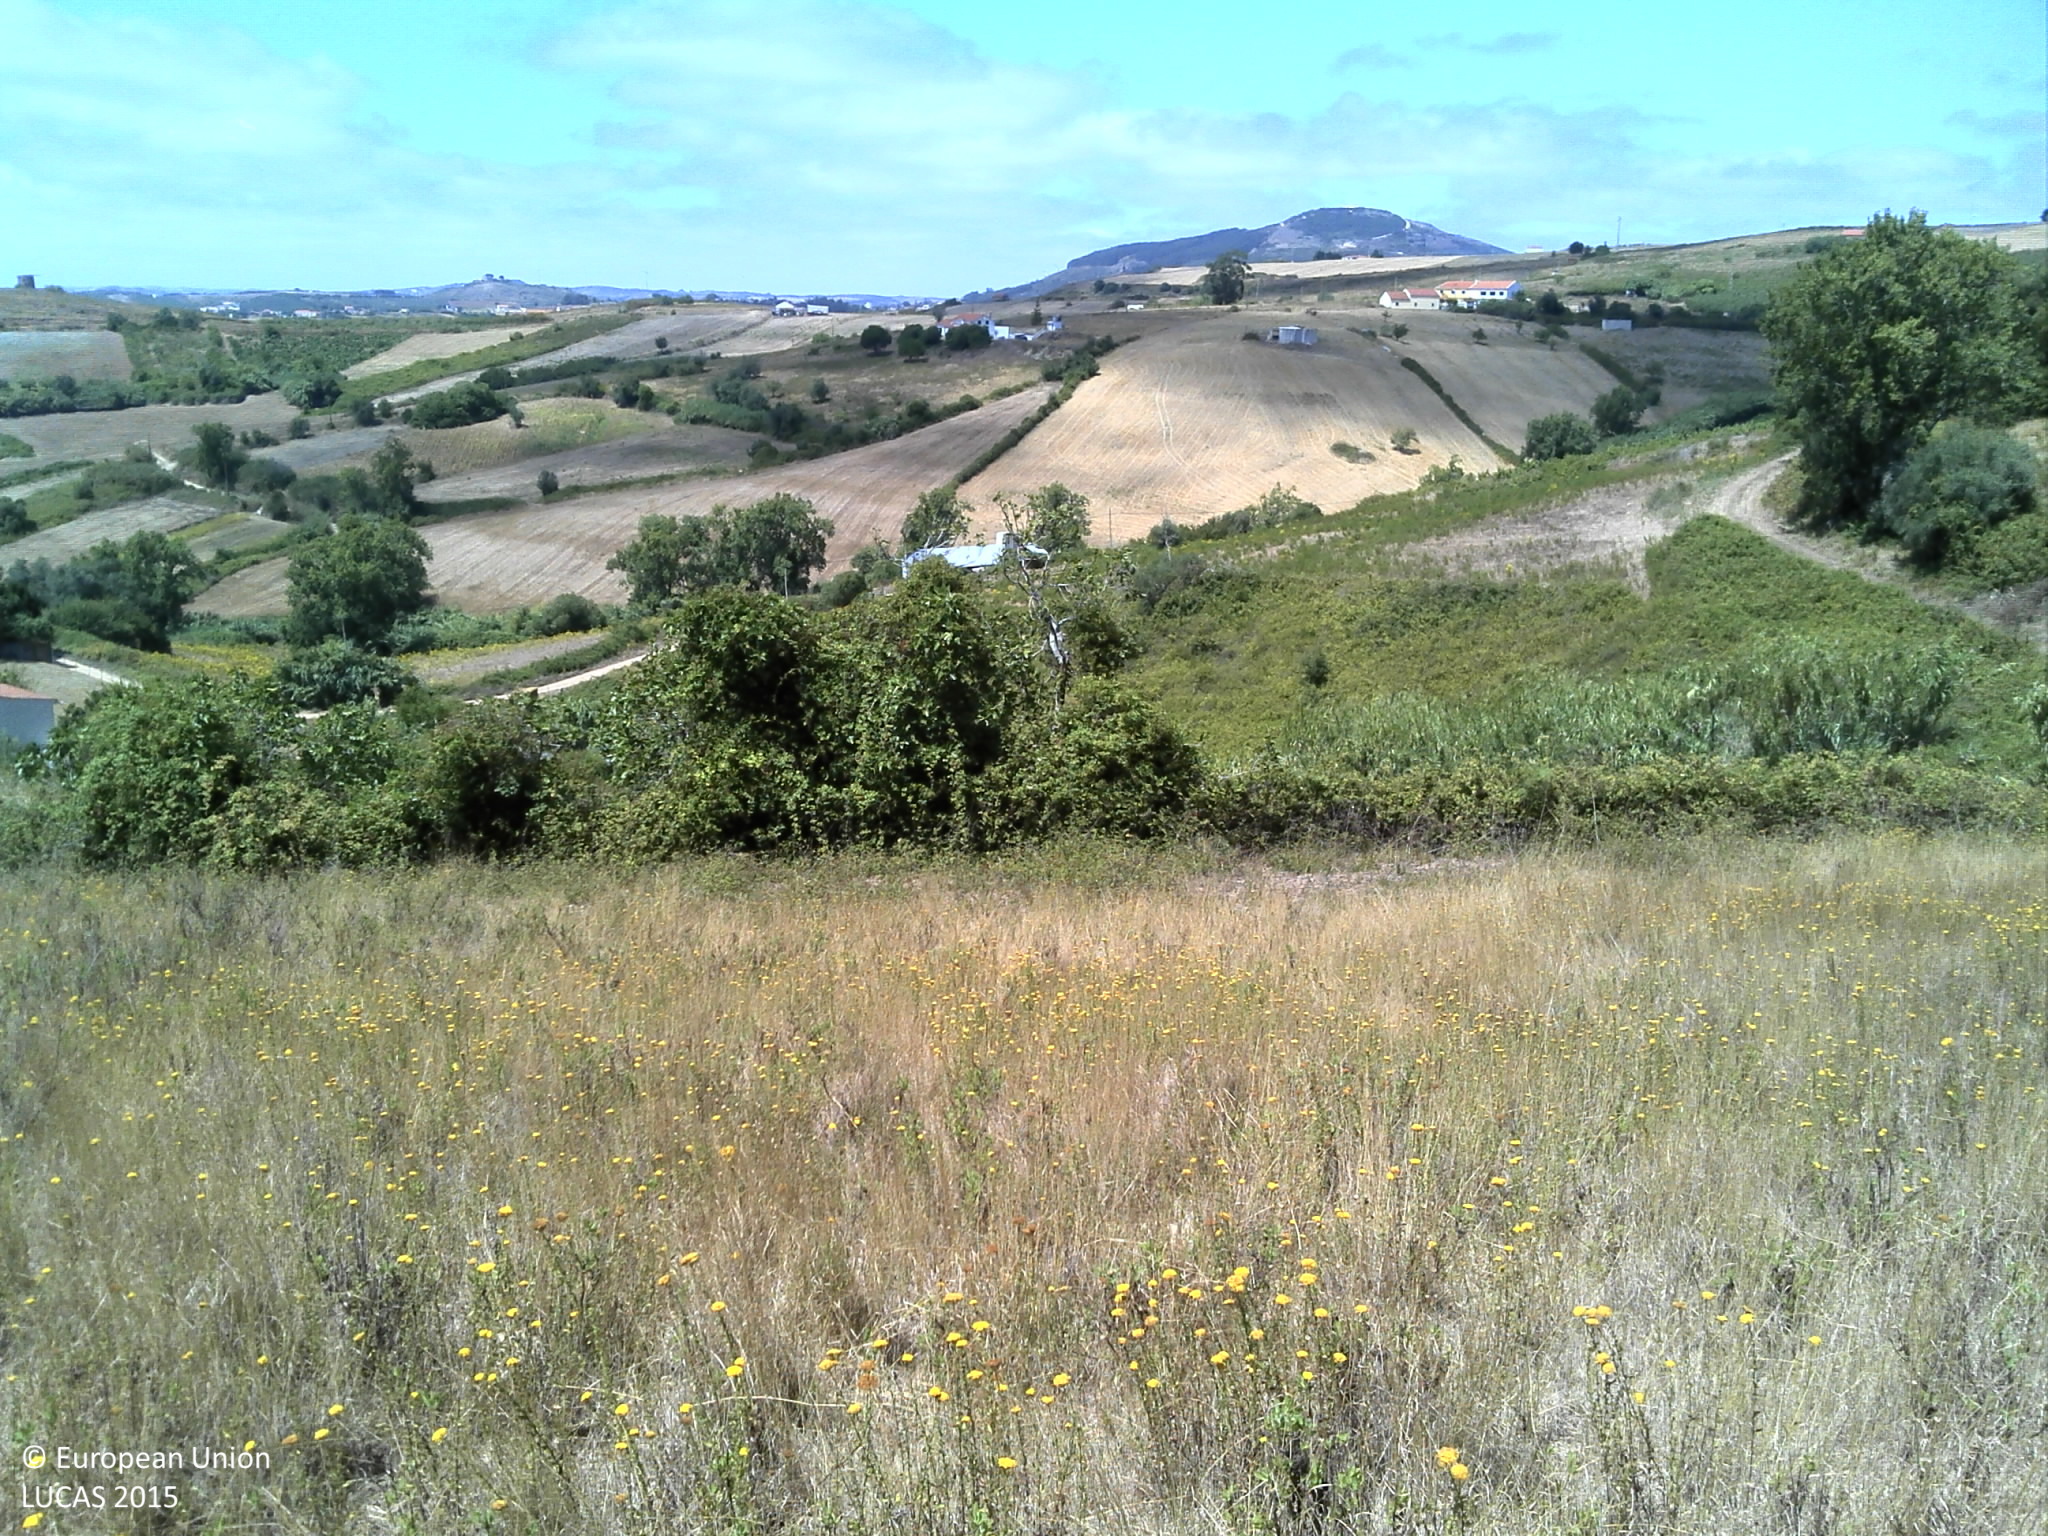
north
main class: Grassland
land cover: Grassland without tree/shrub cover
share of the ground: > 75 %
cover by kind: herbaceous plants 85 %, unconsolidated bare surface 15 %
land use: Agriculture (excluding fallow land and kitchen gardens)
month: July
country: PT
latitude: 38.9744
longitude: -9.2322
